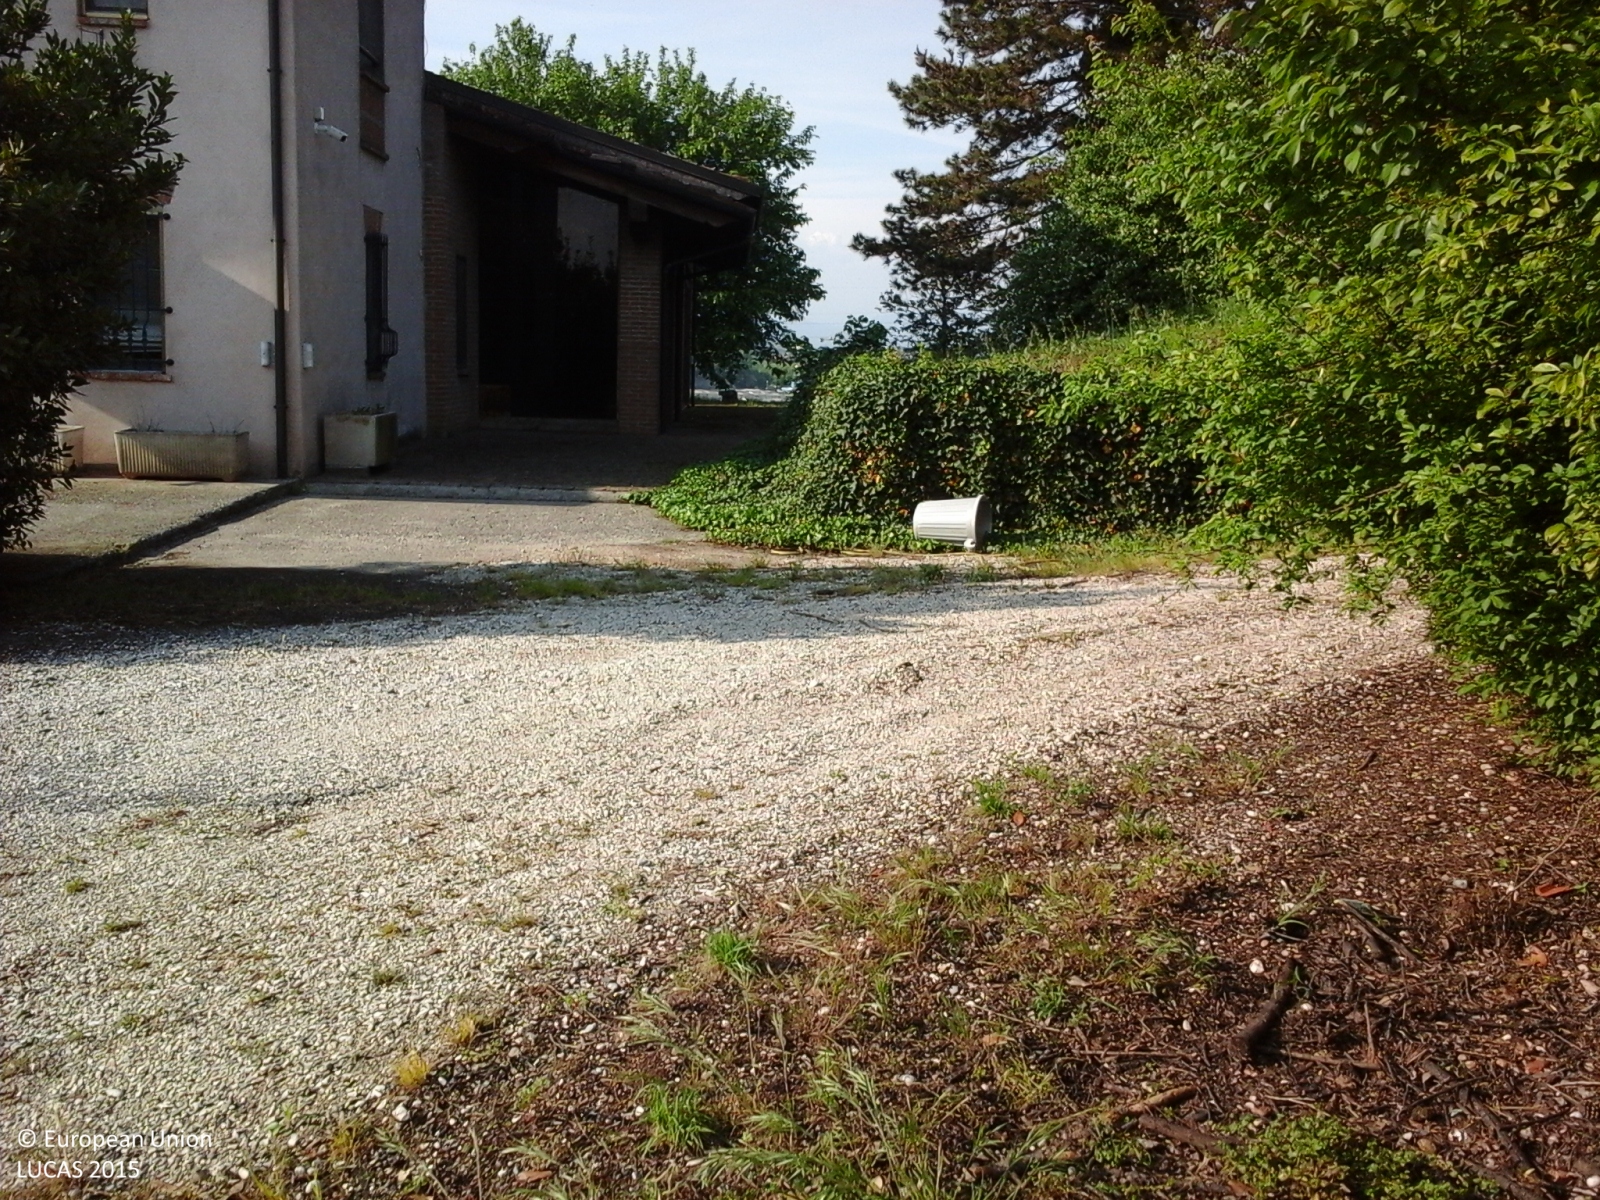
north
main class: Woodland
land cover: Broadleaved woodland
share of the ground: > 75 %
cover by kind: broadleaved forest trees 90 %, consolidated bare surface 10 %
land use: Residential
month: April
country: IT
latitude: 45.3955
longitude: 10.3953
